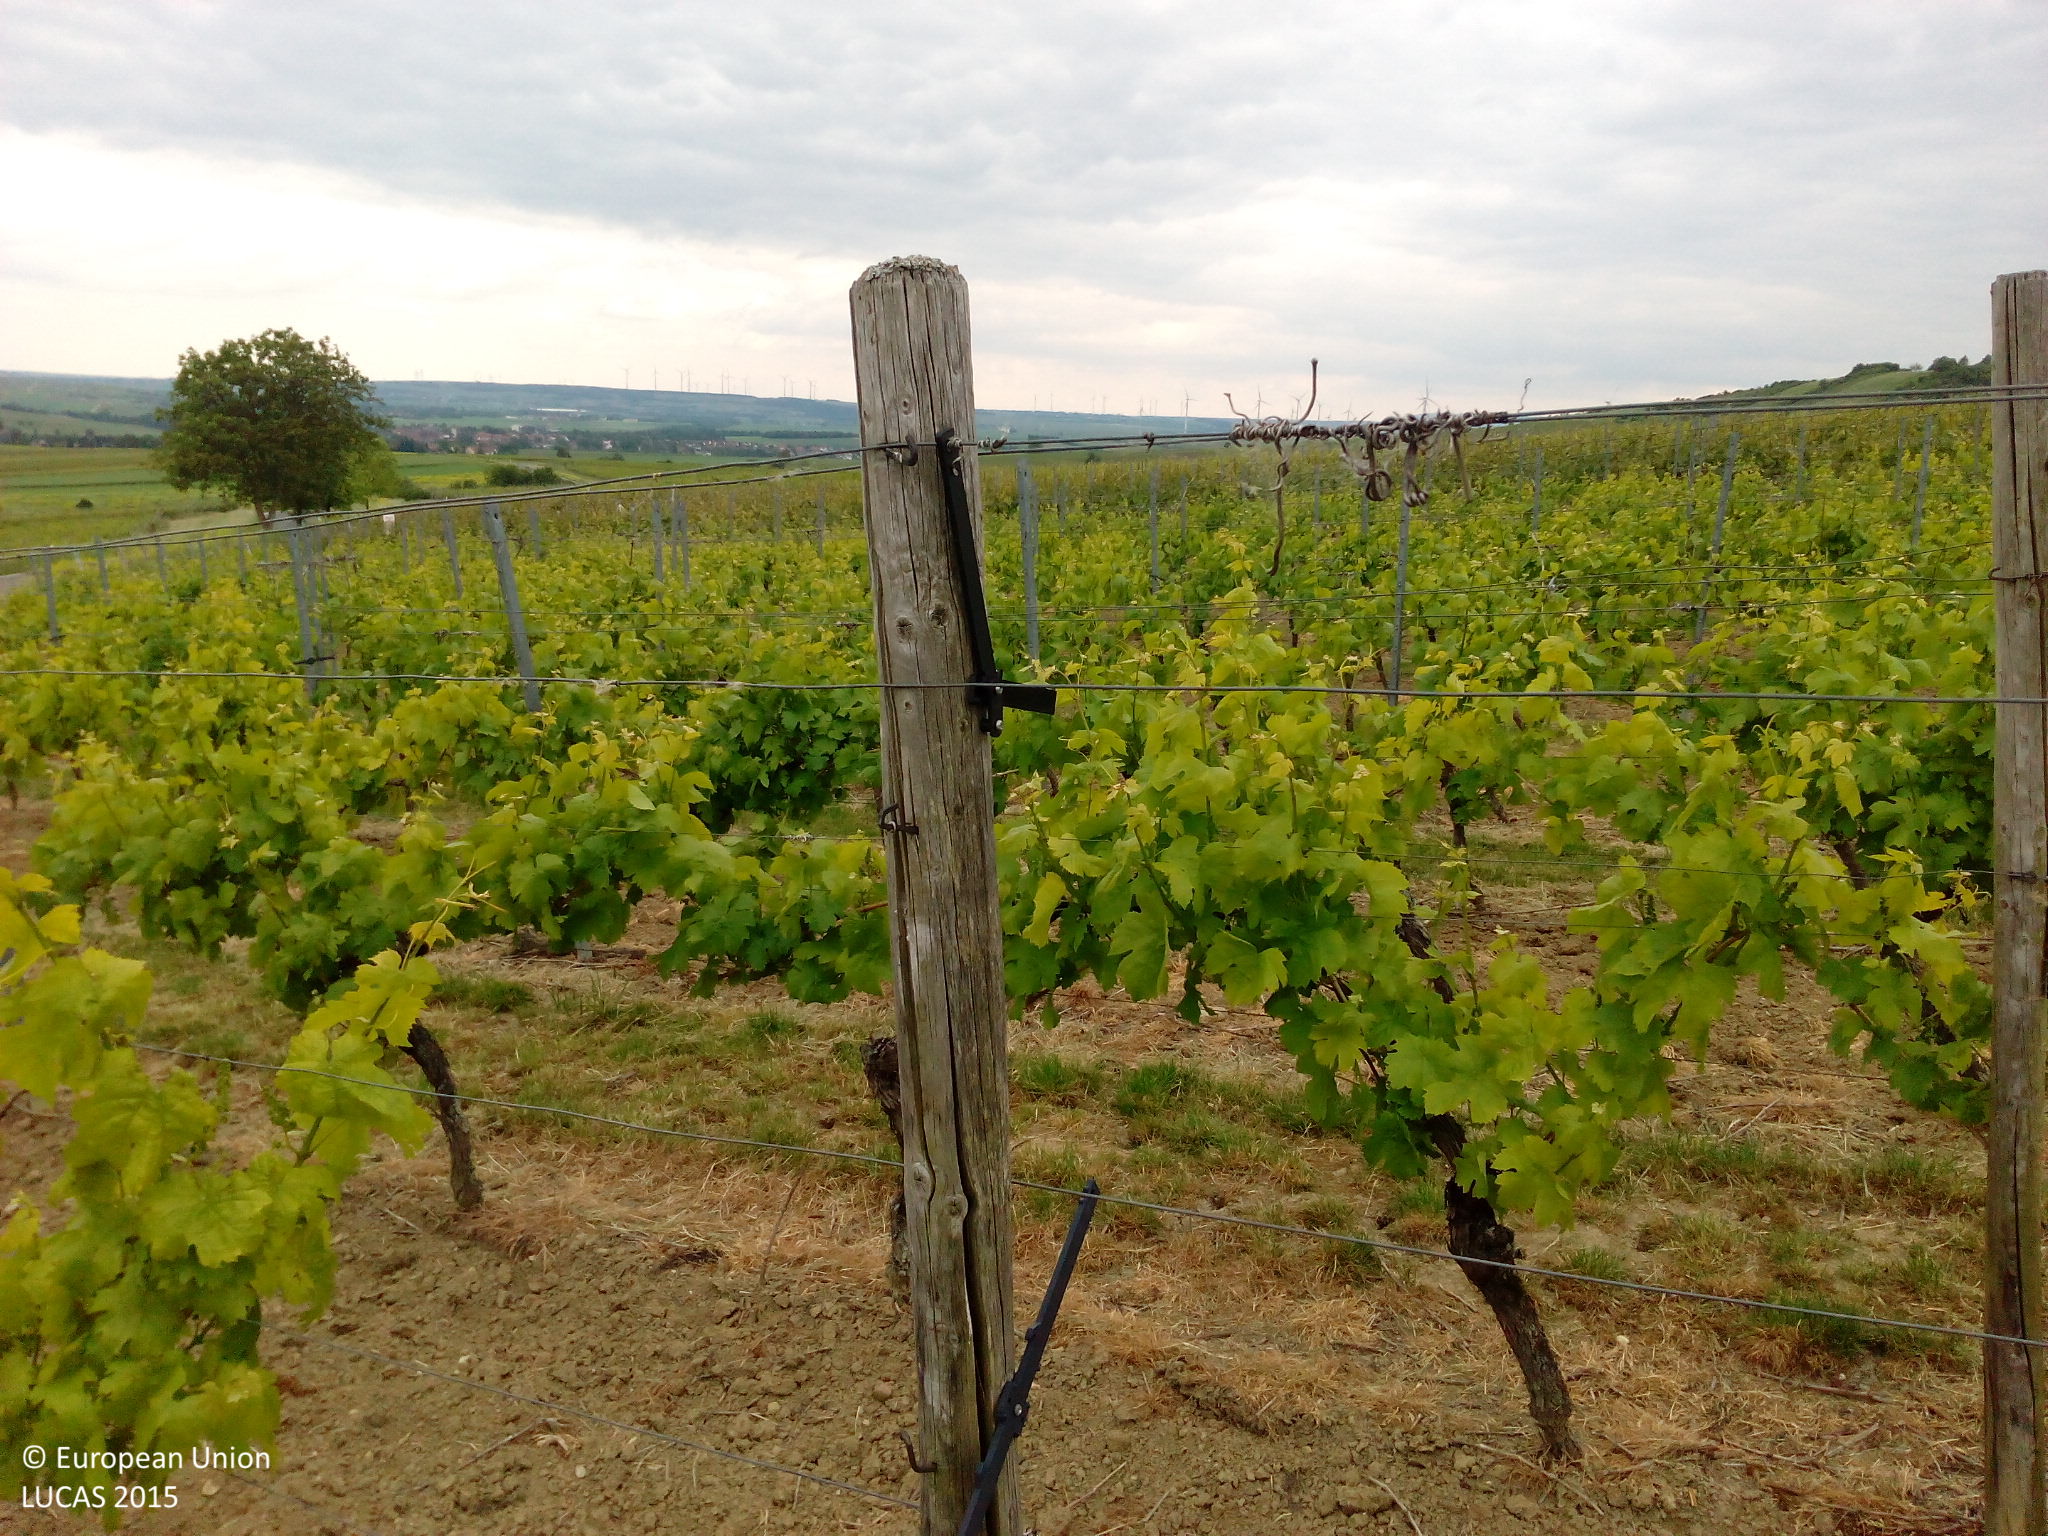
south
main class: Cropland
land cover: Vineyards
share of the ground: 50 - 75 %
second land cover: Grassland without tree/shrub cover
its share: 50 - 75 %
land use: Agriculture (excluding fallow land and kitchen gardens)
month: May
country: DE
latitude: 49.8616
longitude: 8.0390
